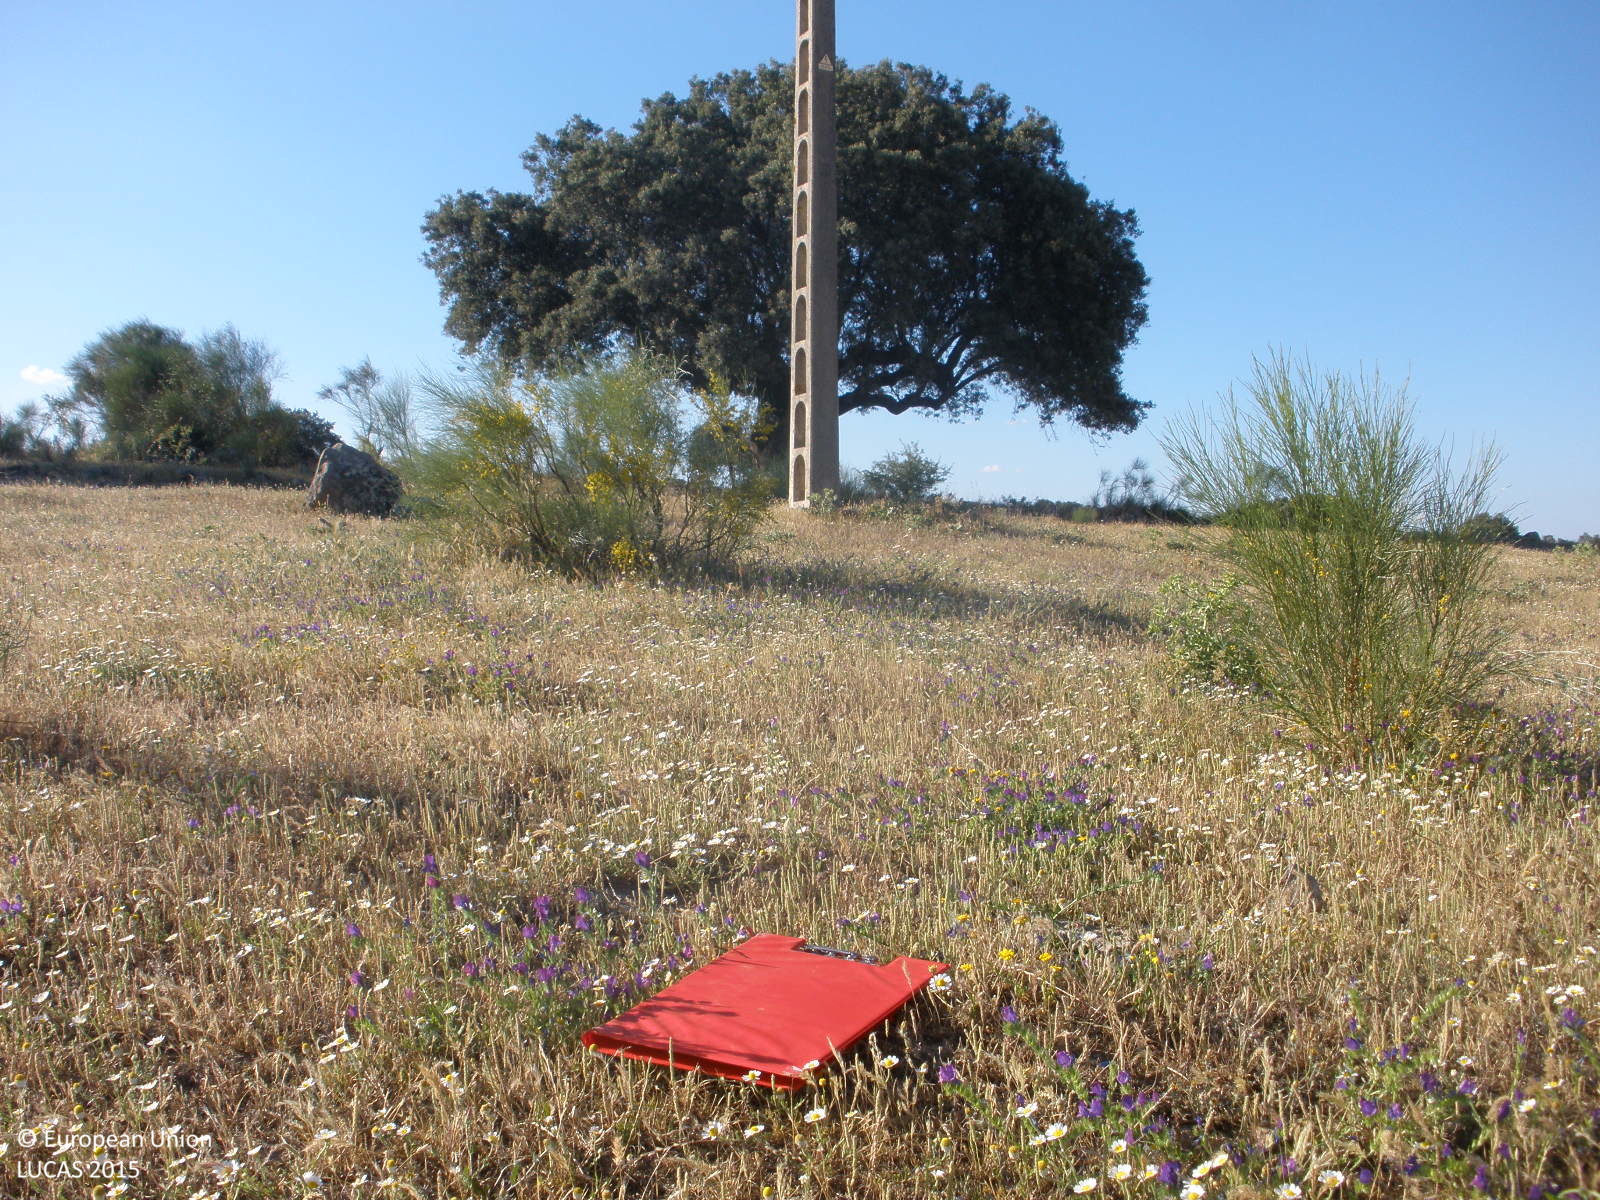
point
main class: Grassland
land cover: Grassland without tree/shrub cover
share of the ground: > 75 %
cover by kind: herbaceous plants 100 %
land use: Agriculture (excluding fallow land and kitchen gardens)
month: May
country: ES
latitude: 40.1026
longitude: -6.2288
